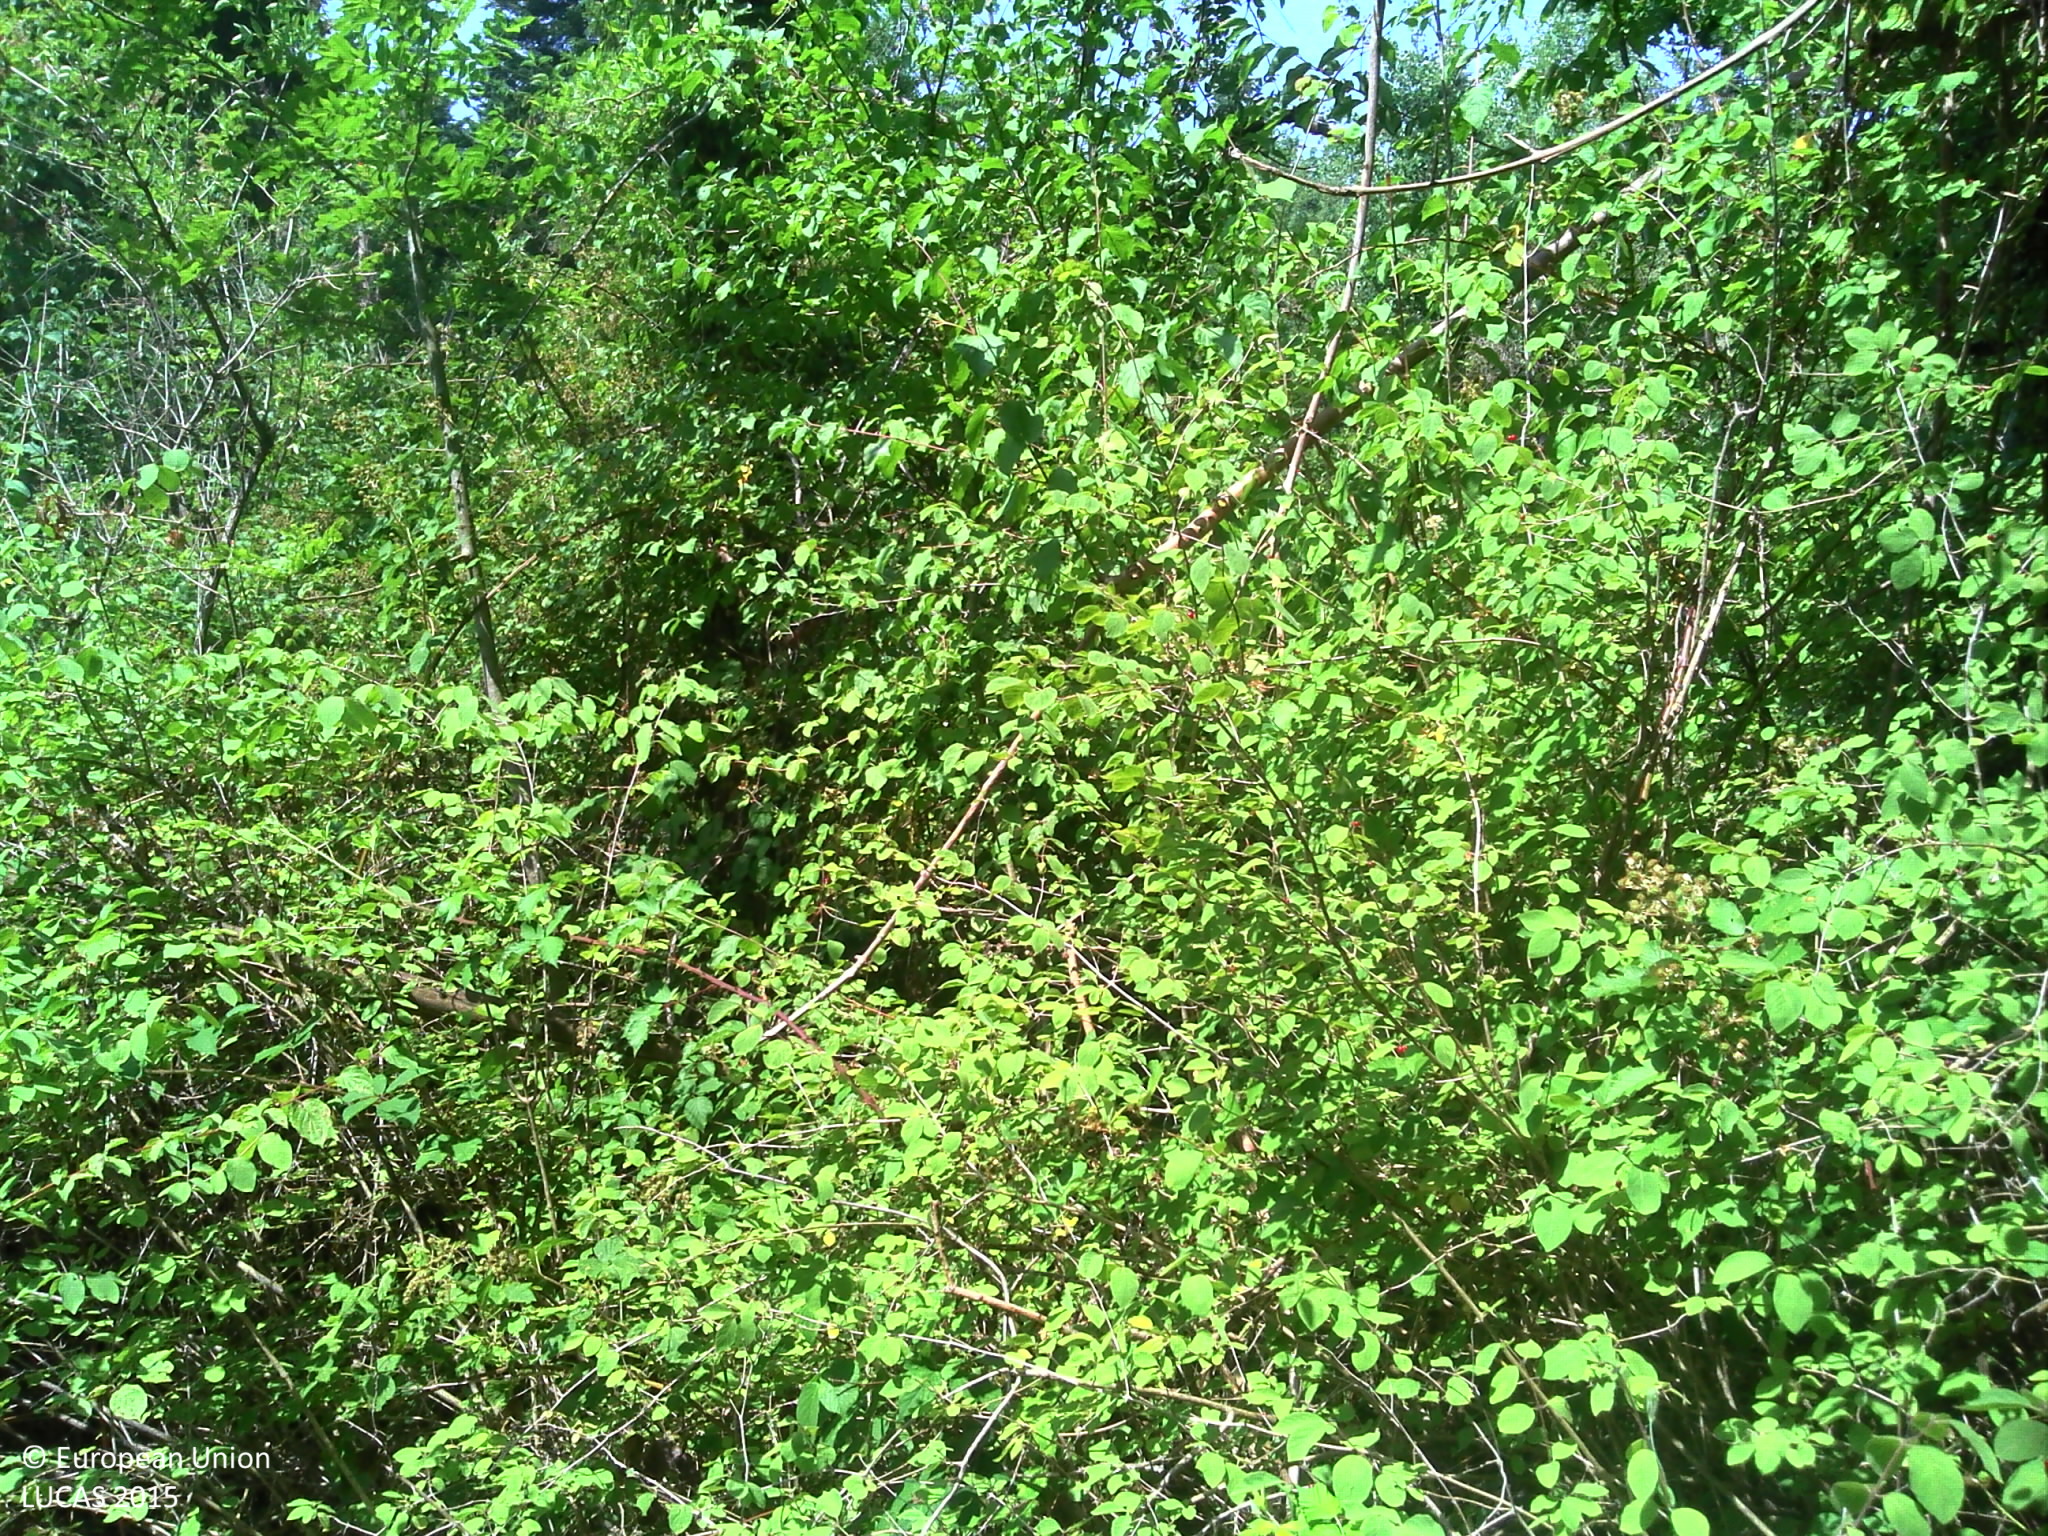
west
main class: Woodland
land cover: Spruce dominated mixed woodland
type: mountainous beech forest
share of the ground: > 75 %
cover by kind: coniferous forest trees 30 %, broadleaved forest trees 30 %, shrubs 15 %, herbaceous plants 15 %, lichens and mosses 10 %
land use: Forestry
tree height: > 5 m
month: July
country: FR
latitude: 46.1417
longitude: 6.2623
